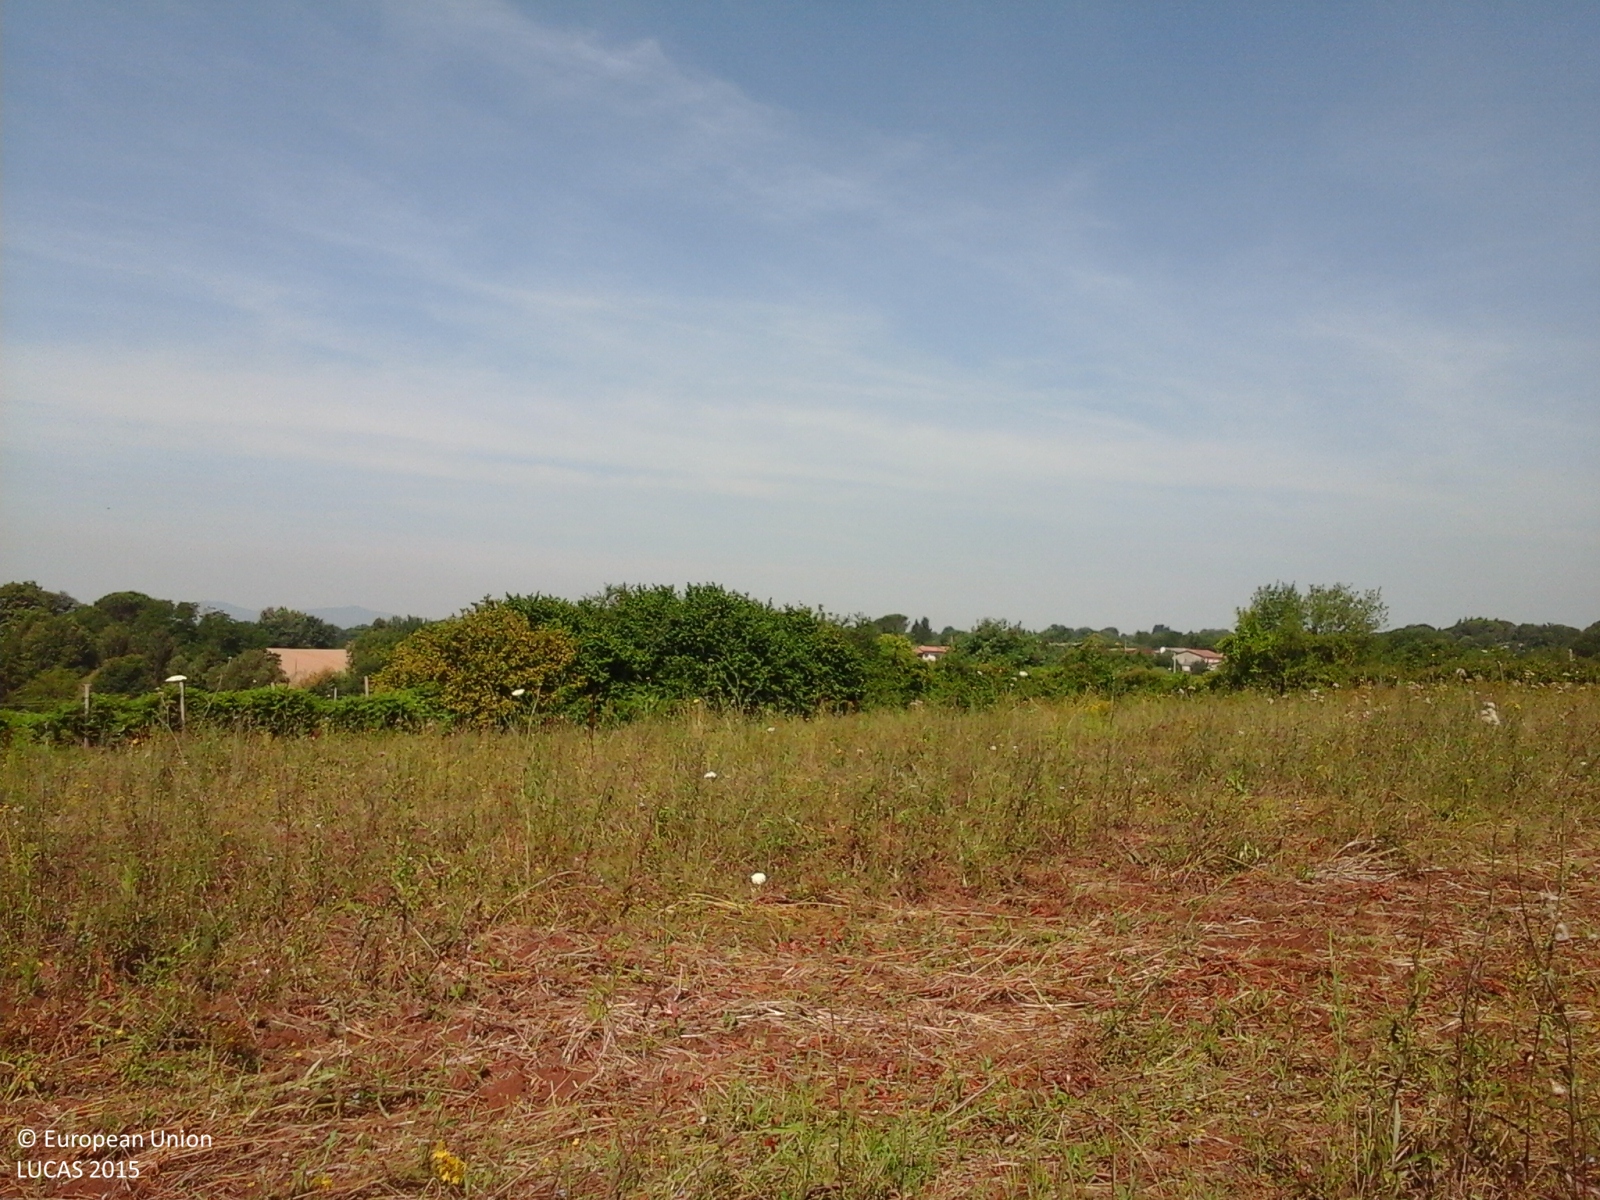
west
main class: Grassland
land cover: Grassland without tree/shrub cover
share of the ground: 50 - 75 %
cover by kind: herbaceous plants 100 %
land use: Agriculture (excluding fallow land and kitchen gardens)
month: June
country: IT
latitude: 41.7965
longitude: 12.9855
